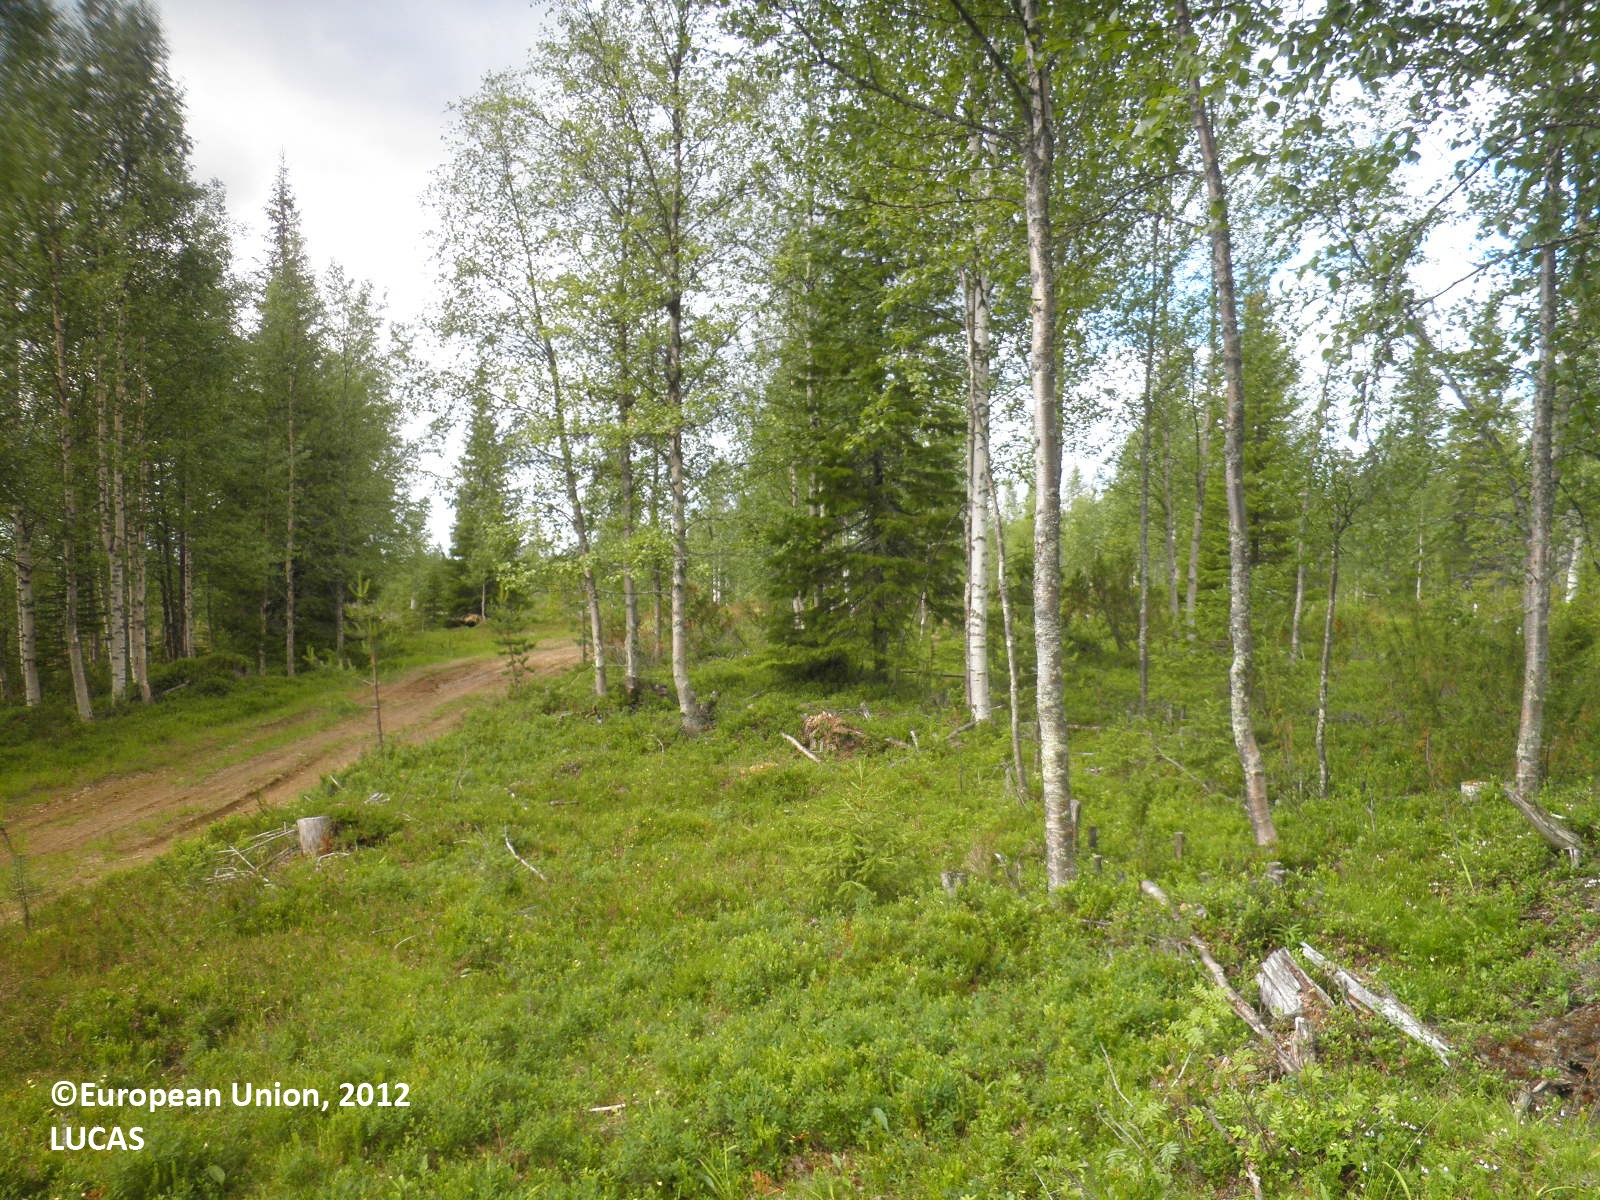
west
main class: Woodland
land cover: Broadleaved woodland
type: boreal forest
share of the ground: 50 - 75 %
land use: Forestry
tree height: > 5 m
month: July
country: FI
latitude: 67.6860
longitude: 26.1322
